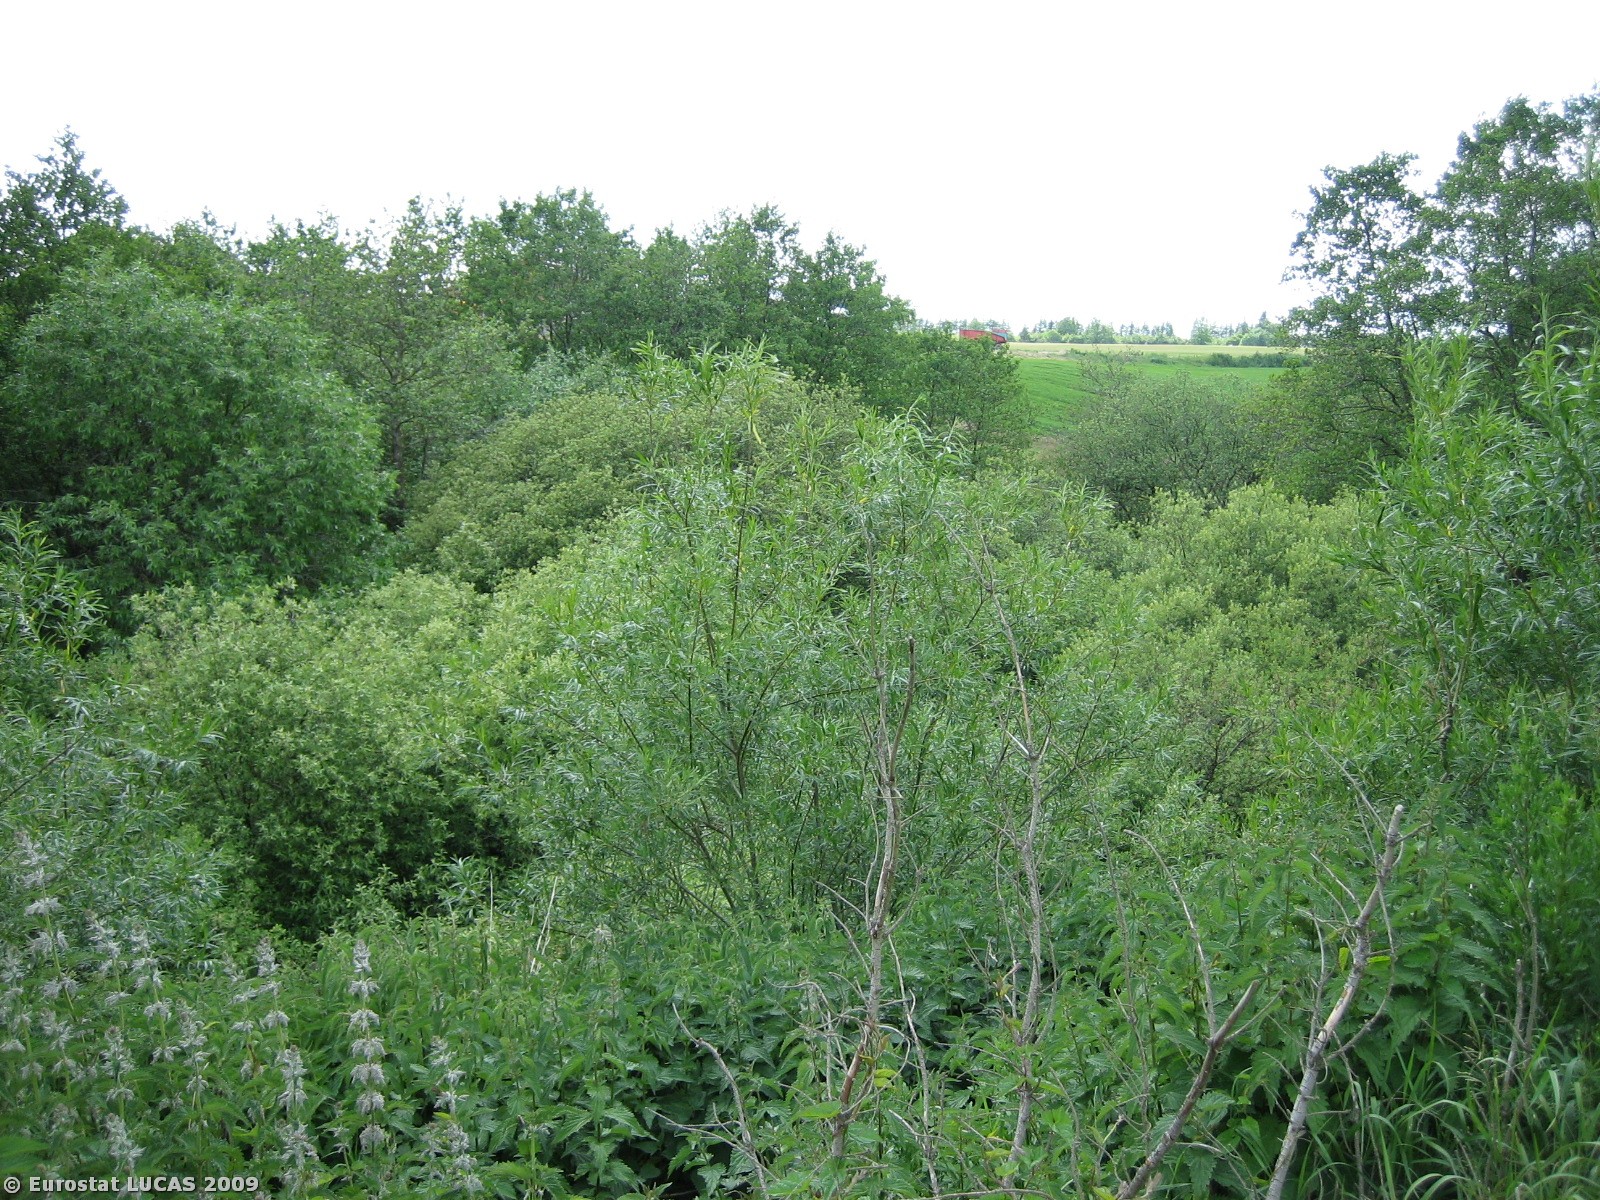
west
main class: Woodland
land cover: Broadleaved woodland
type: mesophytic deciduous forest
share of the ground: > 75 %
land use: Forestry
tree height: > 5 m
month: June
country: DK
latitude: 55.6102
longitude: 9.2229
